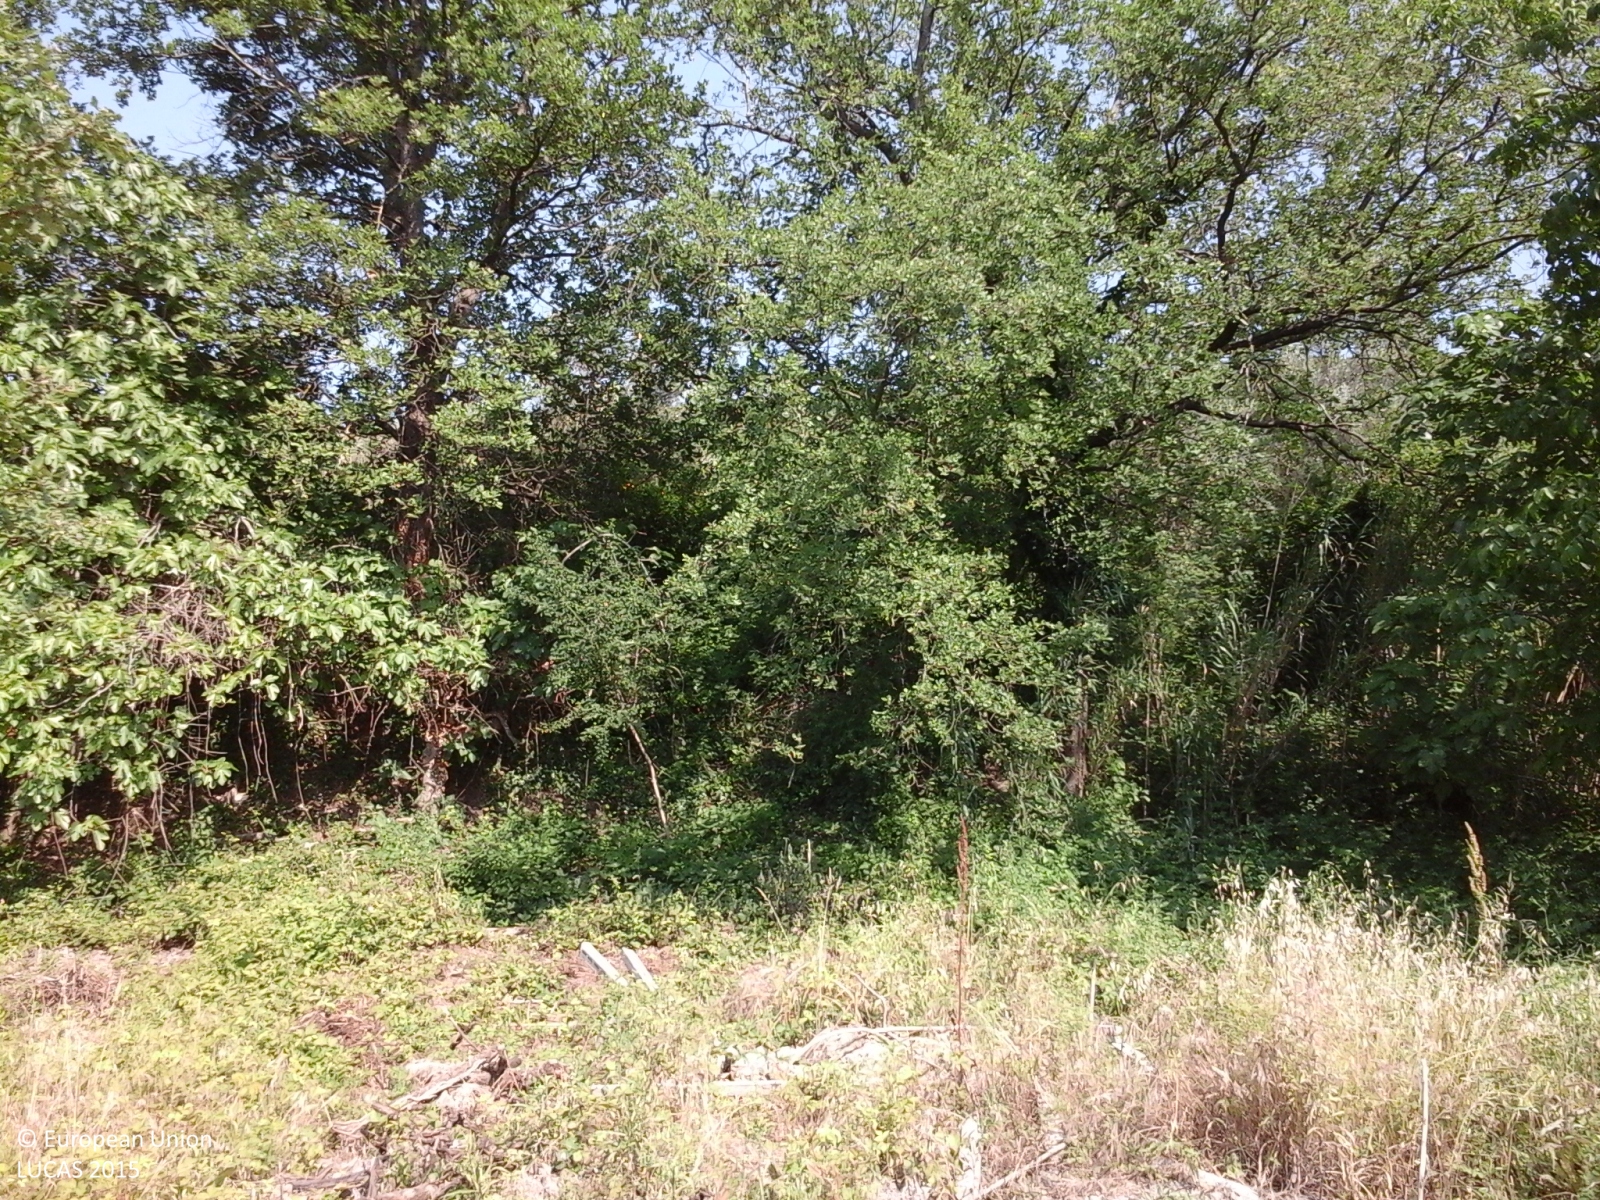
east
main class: Grassland
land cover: Spontaneously vegetated surfaces
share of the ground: > 75 %
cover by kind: herbaceous plants 50 %, consolidated bare surface 50 %
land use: Fallow land
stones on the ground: < 10 %
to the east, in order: Spontaneously vegetated surfaces; Ditches and canals; Shrubland with sparse tree cover; Tracks; Grass margins; Paved roads, cycling and walking lanes; Broadleaved woodland; Railways; Electric lines; Broadleaved woodland
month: June
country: IT
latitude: 42.0722
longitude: 14.3494
